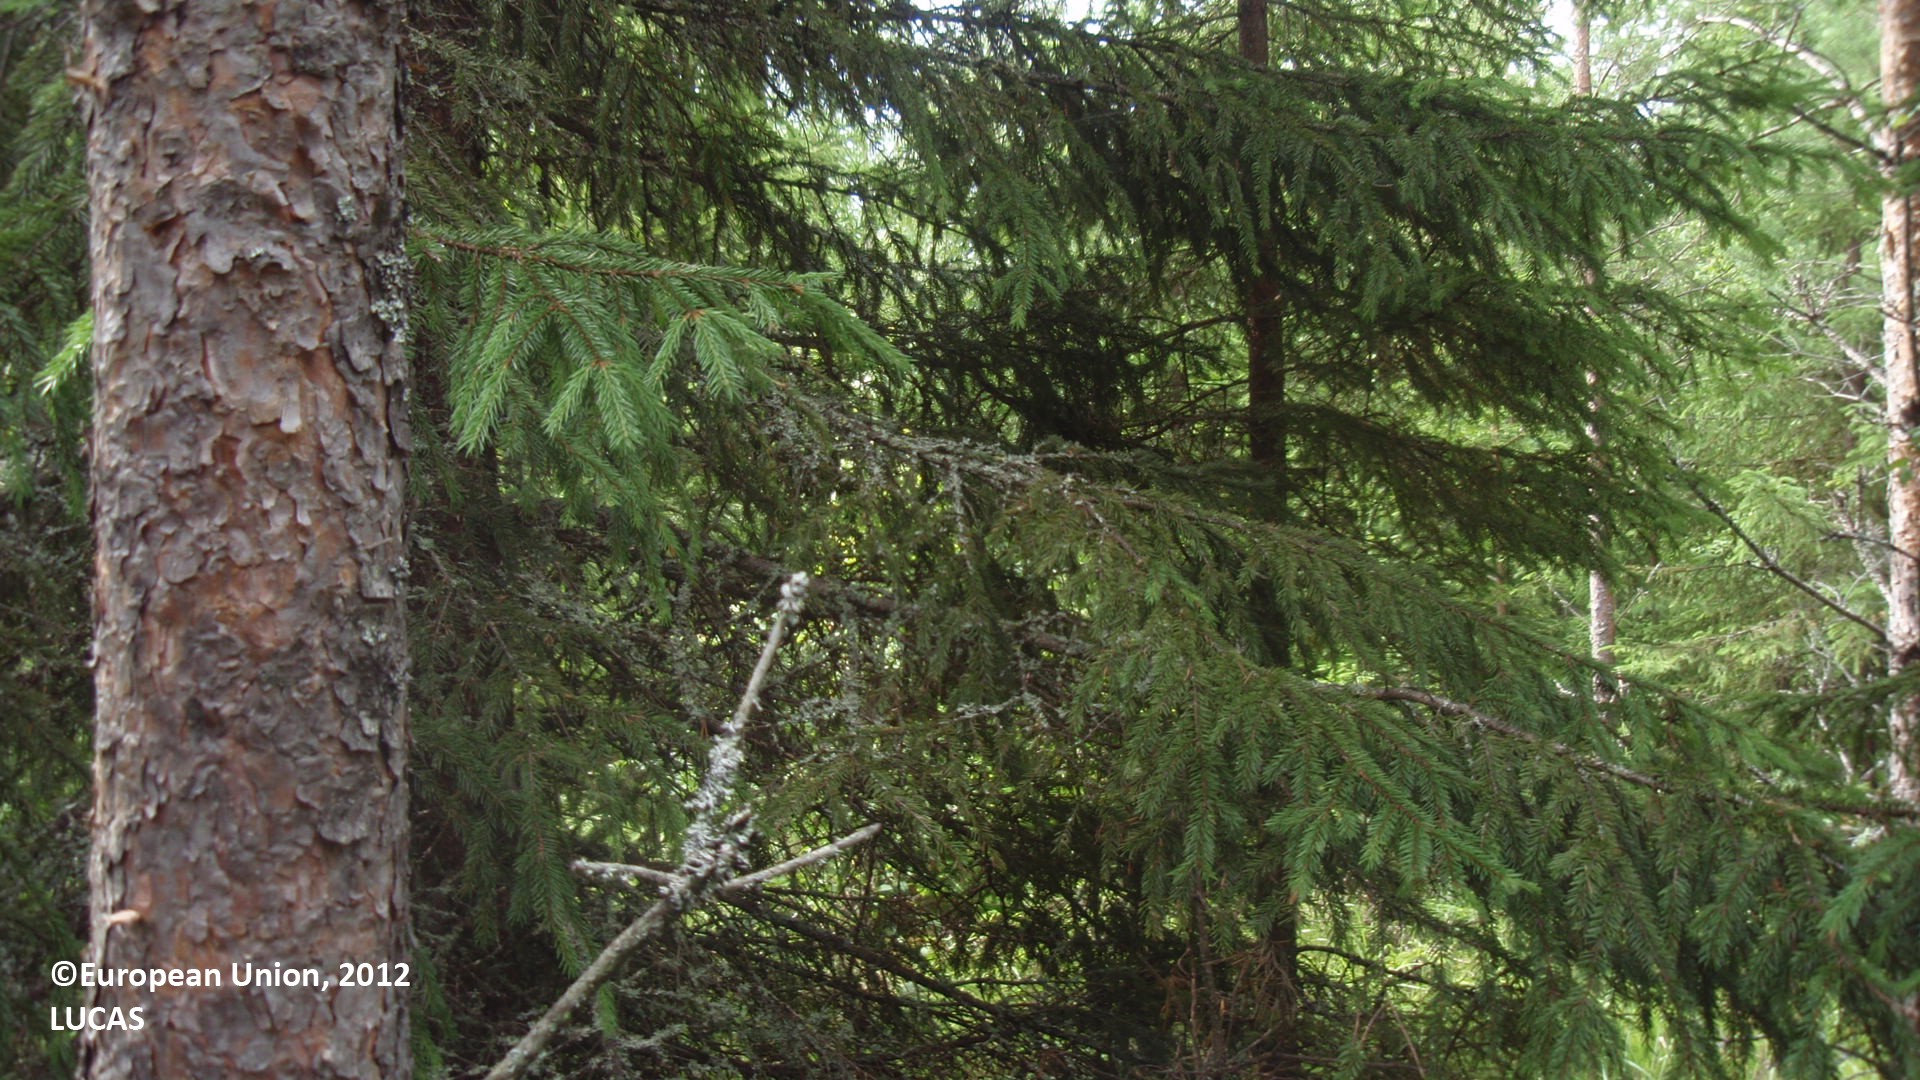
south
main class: Woodland
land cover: Spruce dominated coniferous woodland
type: boreal forest
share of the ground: 25 - 50 %
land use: Forestry
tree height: > 5 m
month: July
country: FI
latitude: 61.4955
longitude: 28.9958
